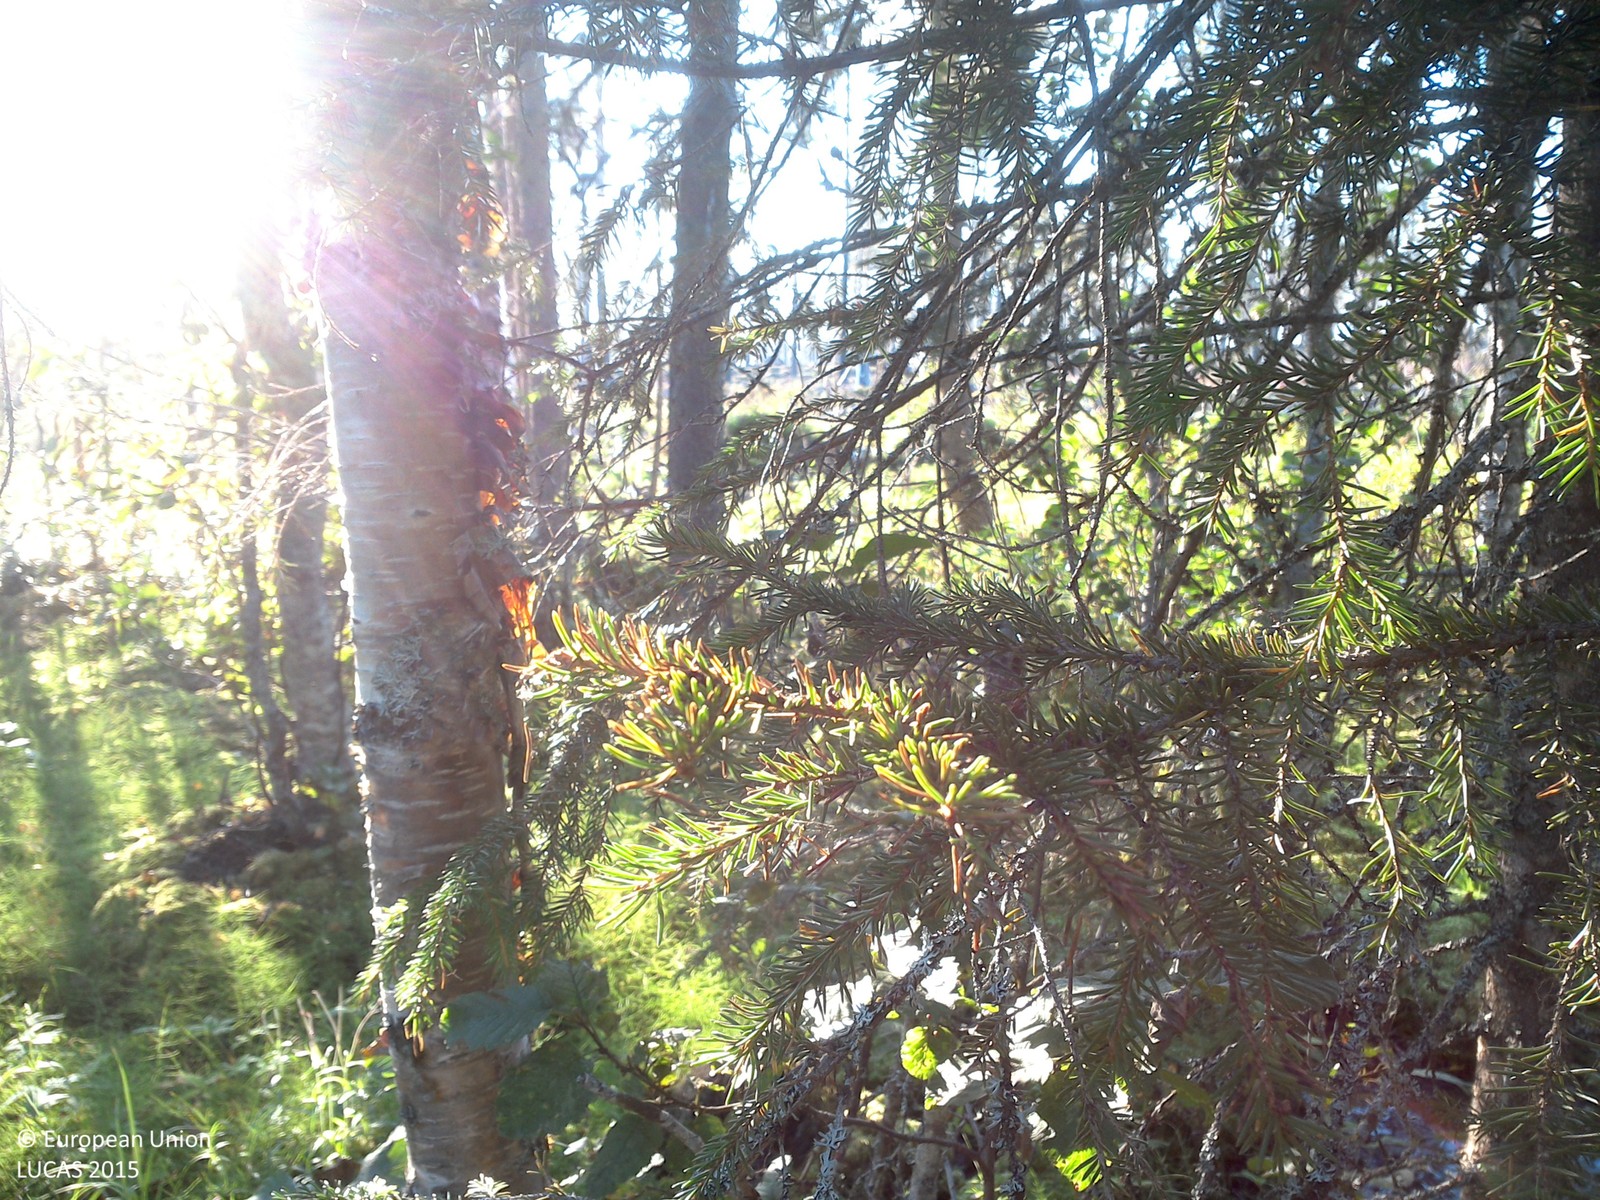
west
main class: Woodland
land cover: Other mixed woodland
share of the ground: 25 - 50 %
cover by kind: herbaceous plants 40 %, broadleaved forest trees 25 %, coniferous forest trees 15 %, lichens and mosses 15 %, shrubs 5 %
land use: Forestry
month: August
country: SE
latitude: 67.1313
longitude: 22.5305
